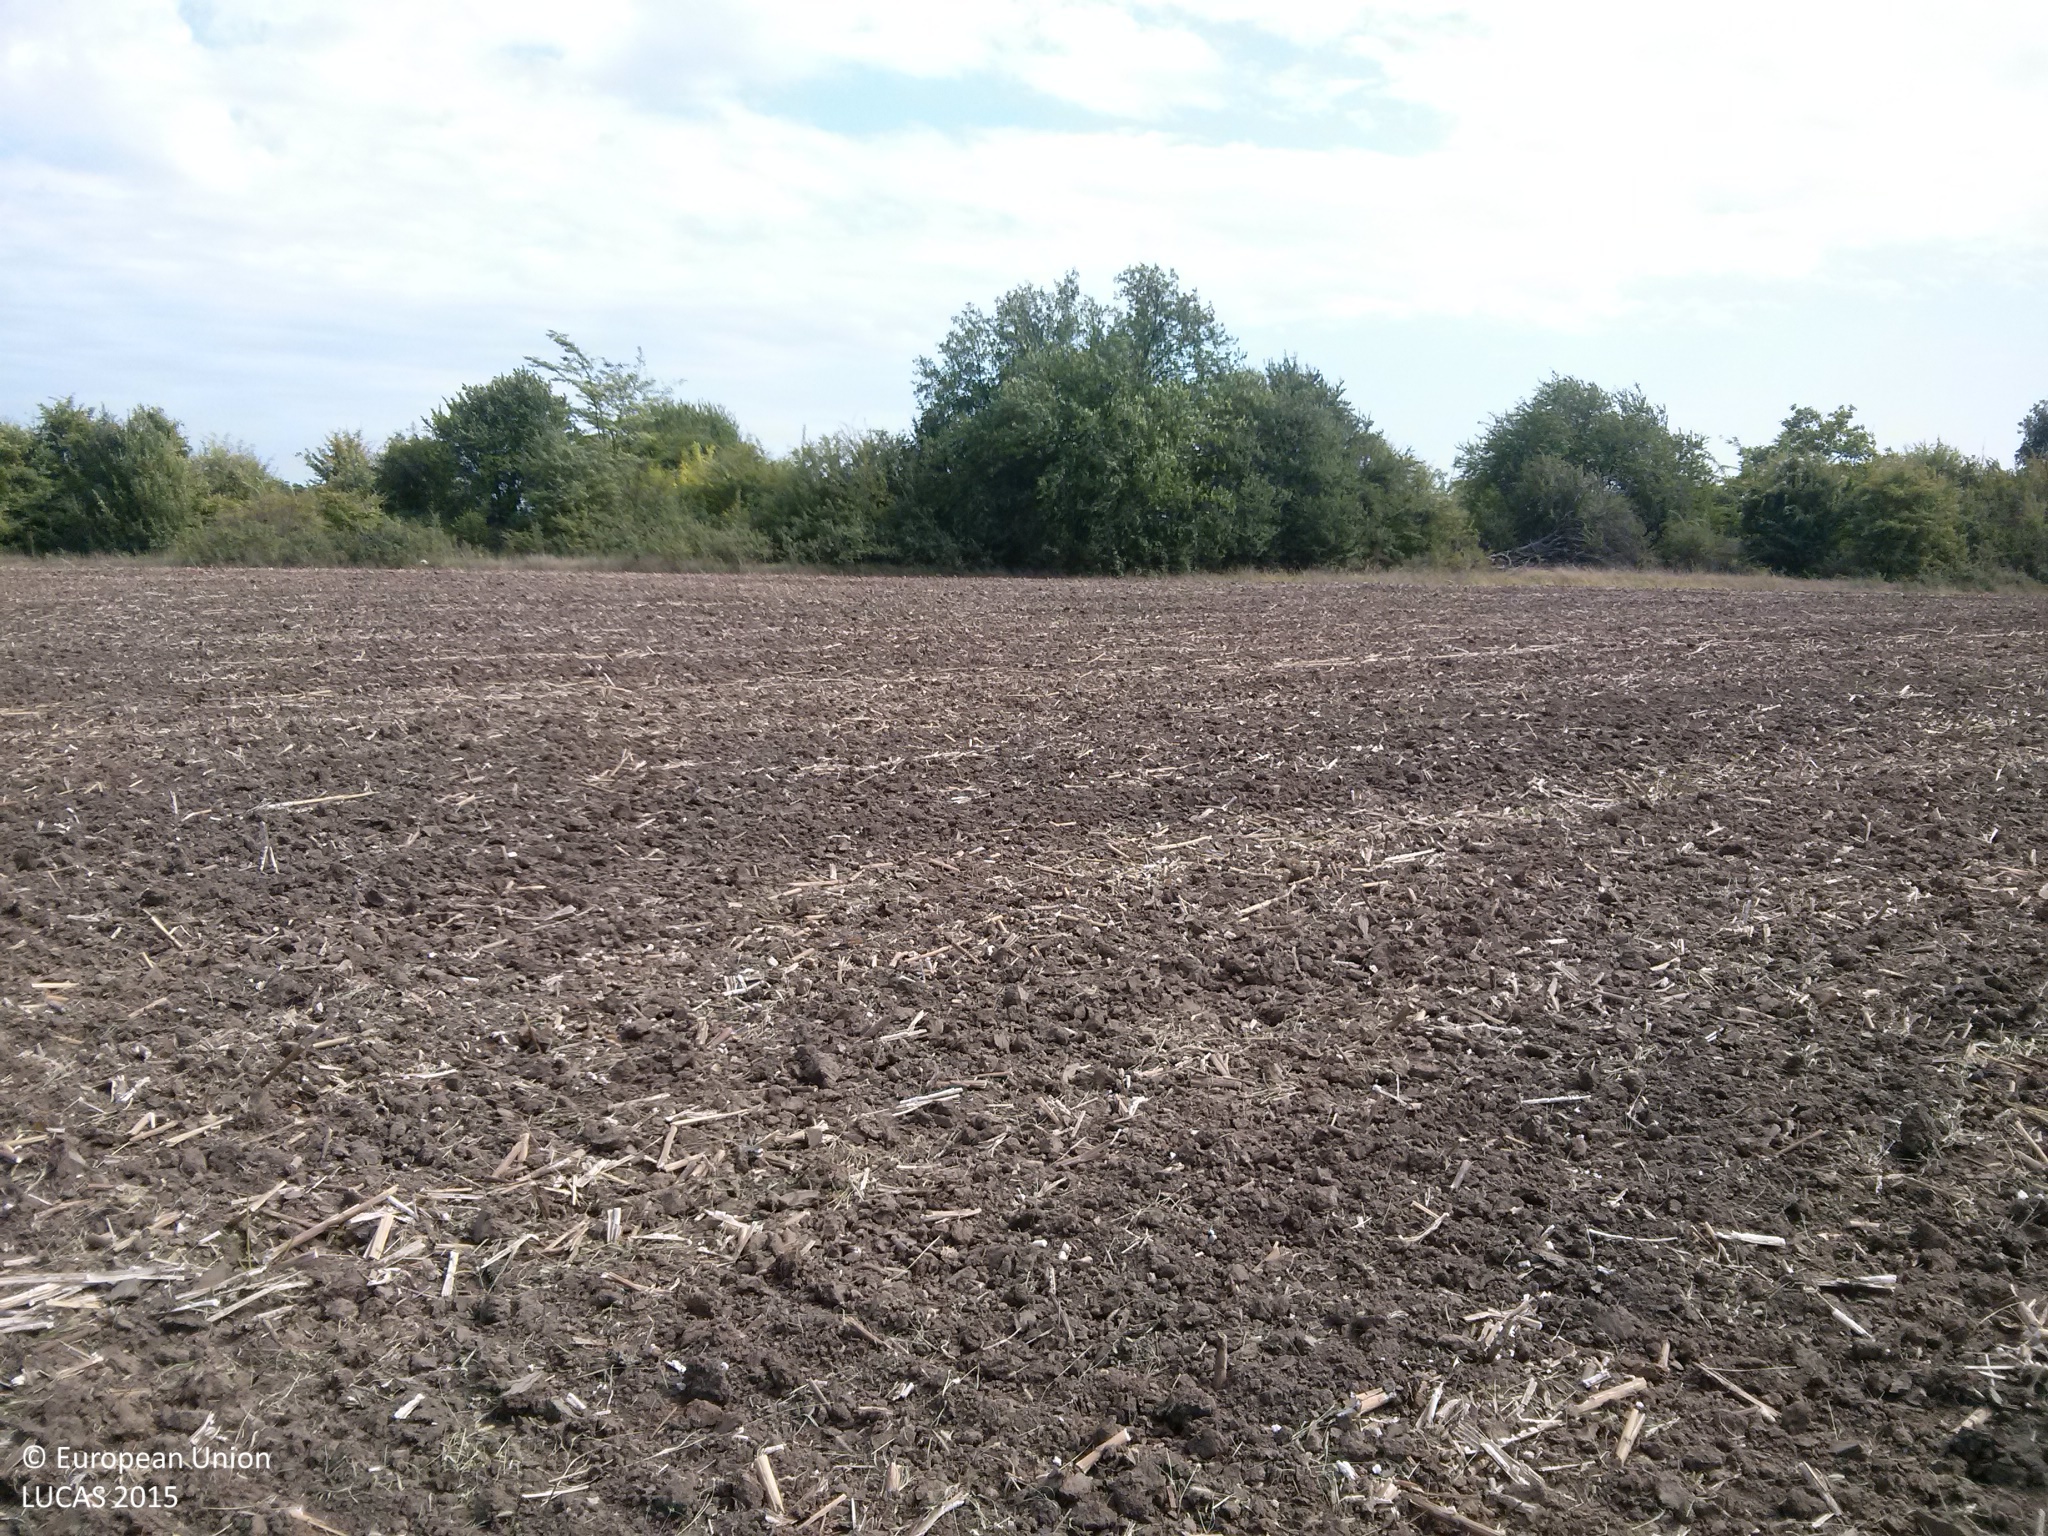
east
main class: Cropland
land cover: Sunflower
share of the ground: < 10 %
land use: Agriculture (excluding fallow land and kitchen gardens)
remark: Harvested field
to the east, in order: Sunflower; Shrubland with sparse tree cover; Ditches and canals; Shrubland with sparse tree cover; Tracks; Sunflower; Electric lines; Sunflower
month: September
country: BG
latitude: 43.8845
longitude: 26.3738
